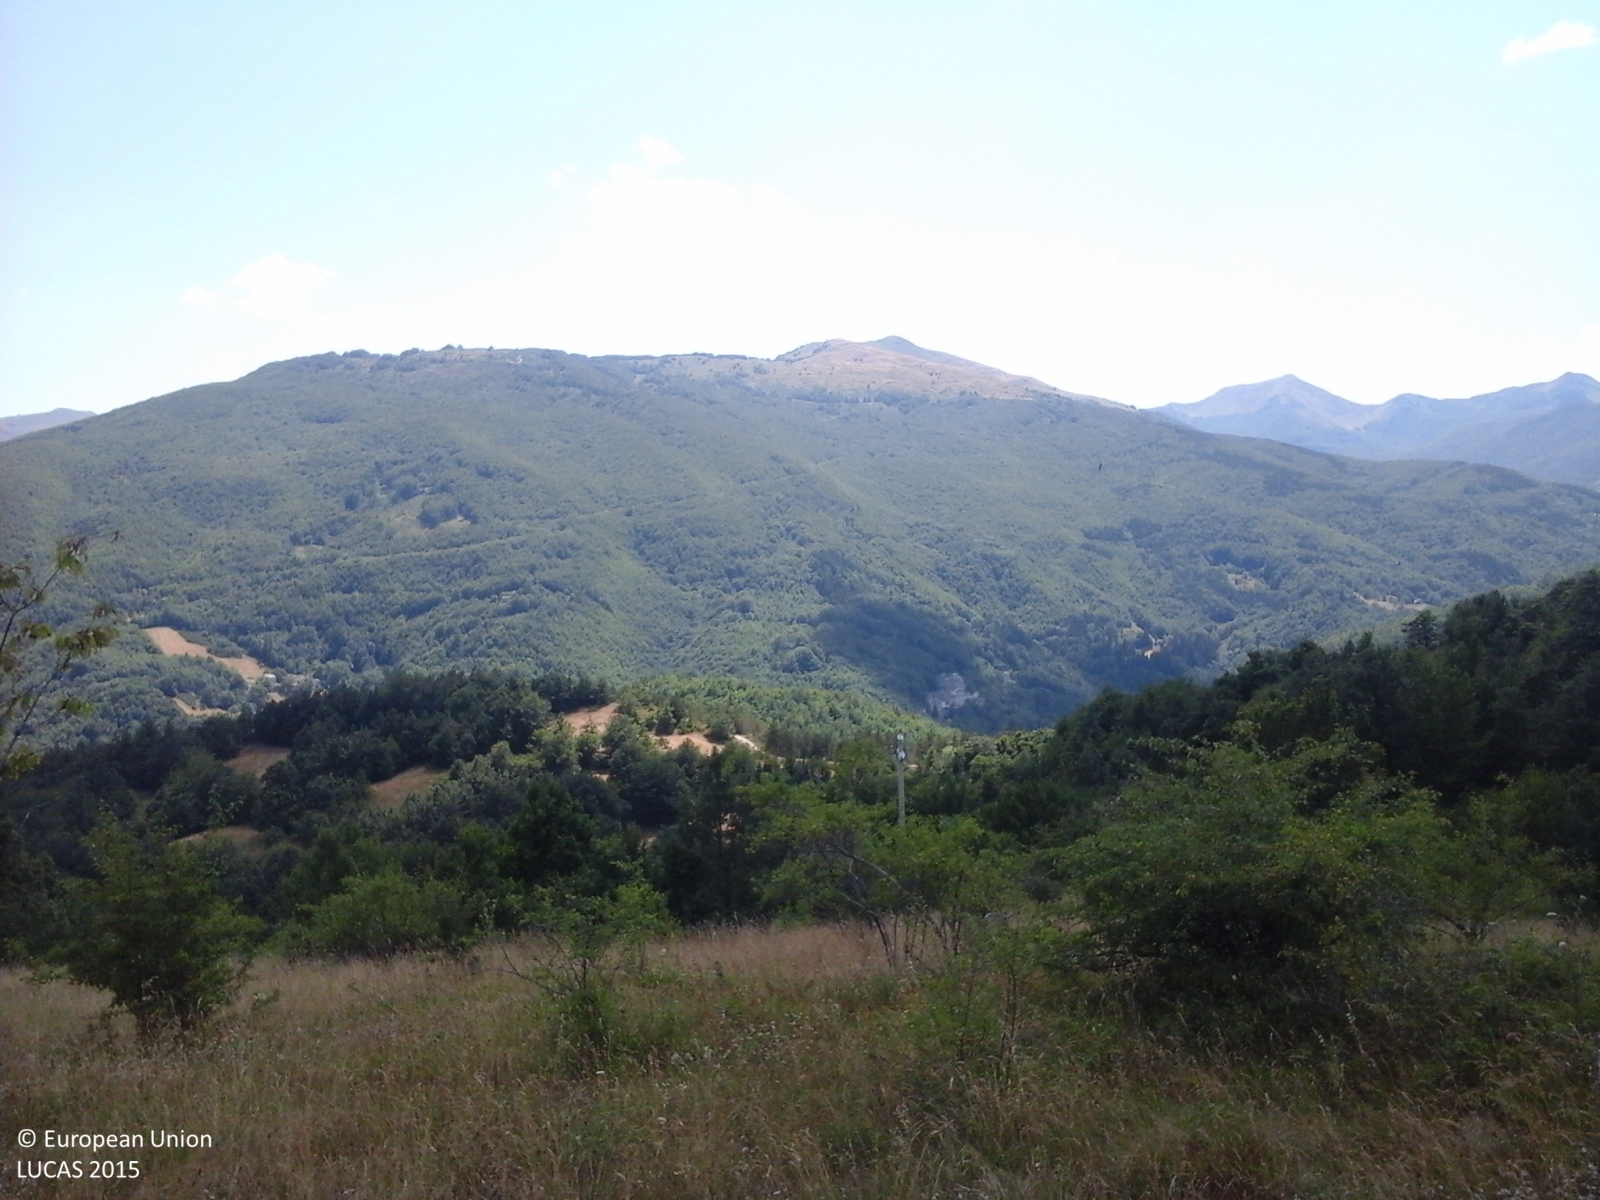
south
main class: Grassland
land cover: Grassland with sparse tree/shrub cover
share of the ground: > 75 %
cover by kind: herbaceous plants 90 %, broadleaved forest trees 5 %, shrubs 5 %
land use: Agriculture (excluding fallow land and kitchen gardens)
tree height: > 5 m
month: July
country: IT
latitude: 44.2046
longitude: 10.5868
